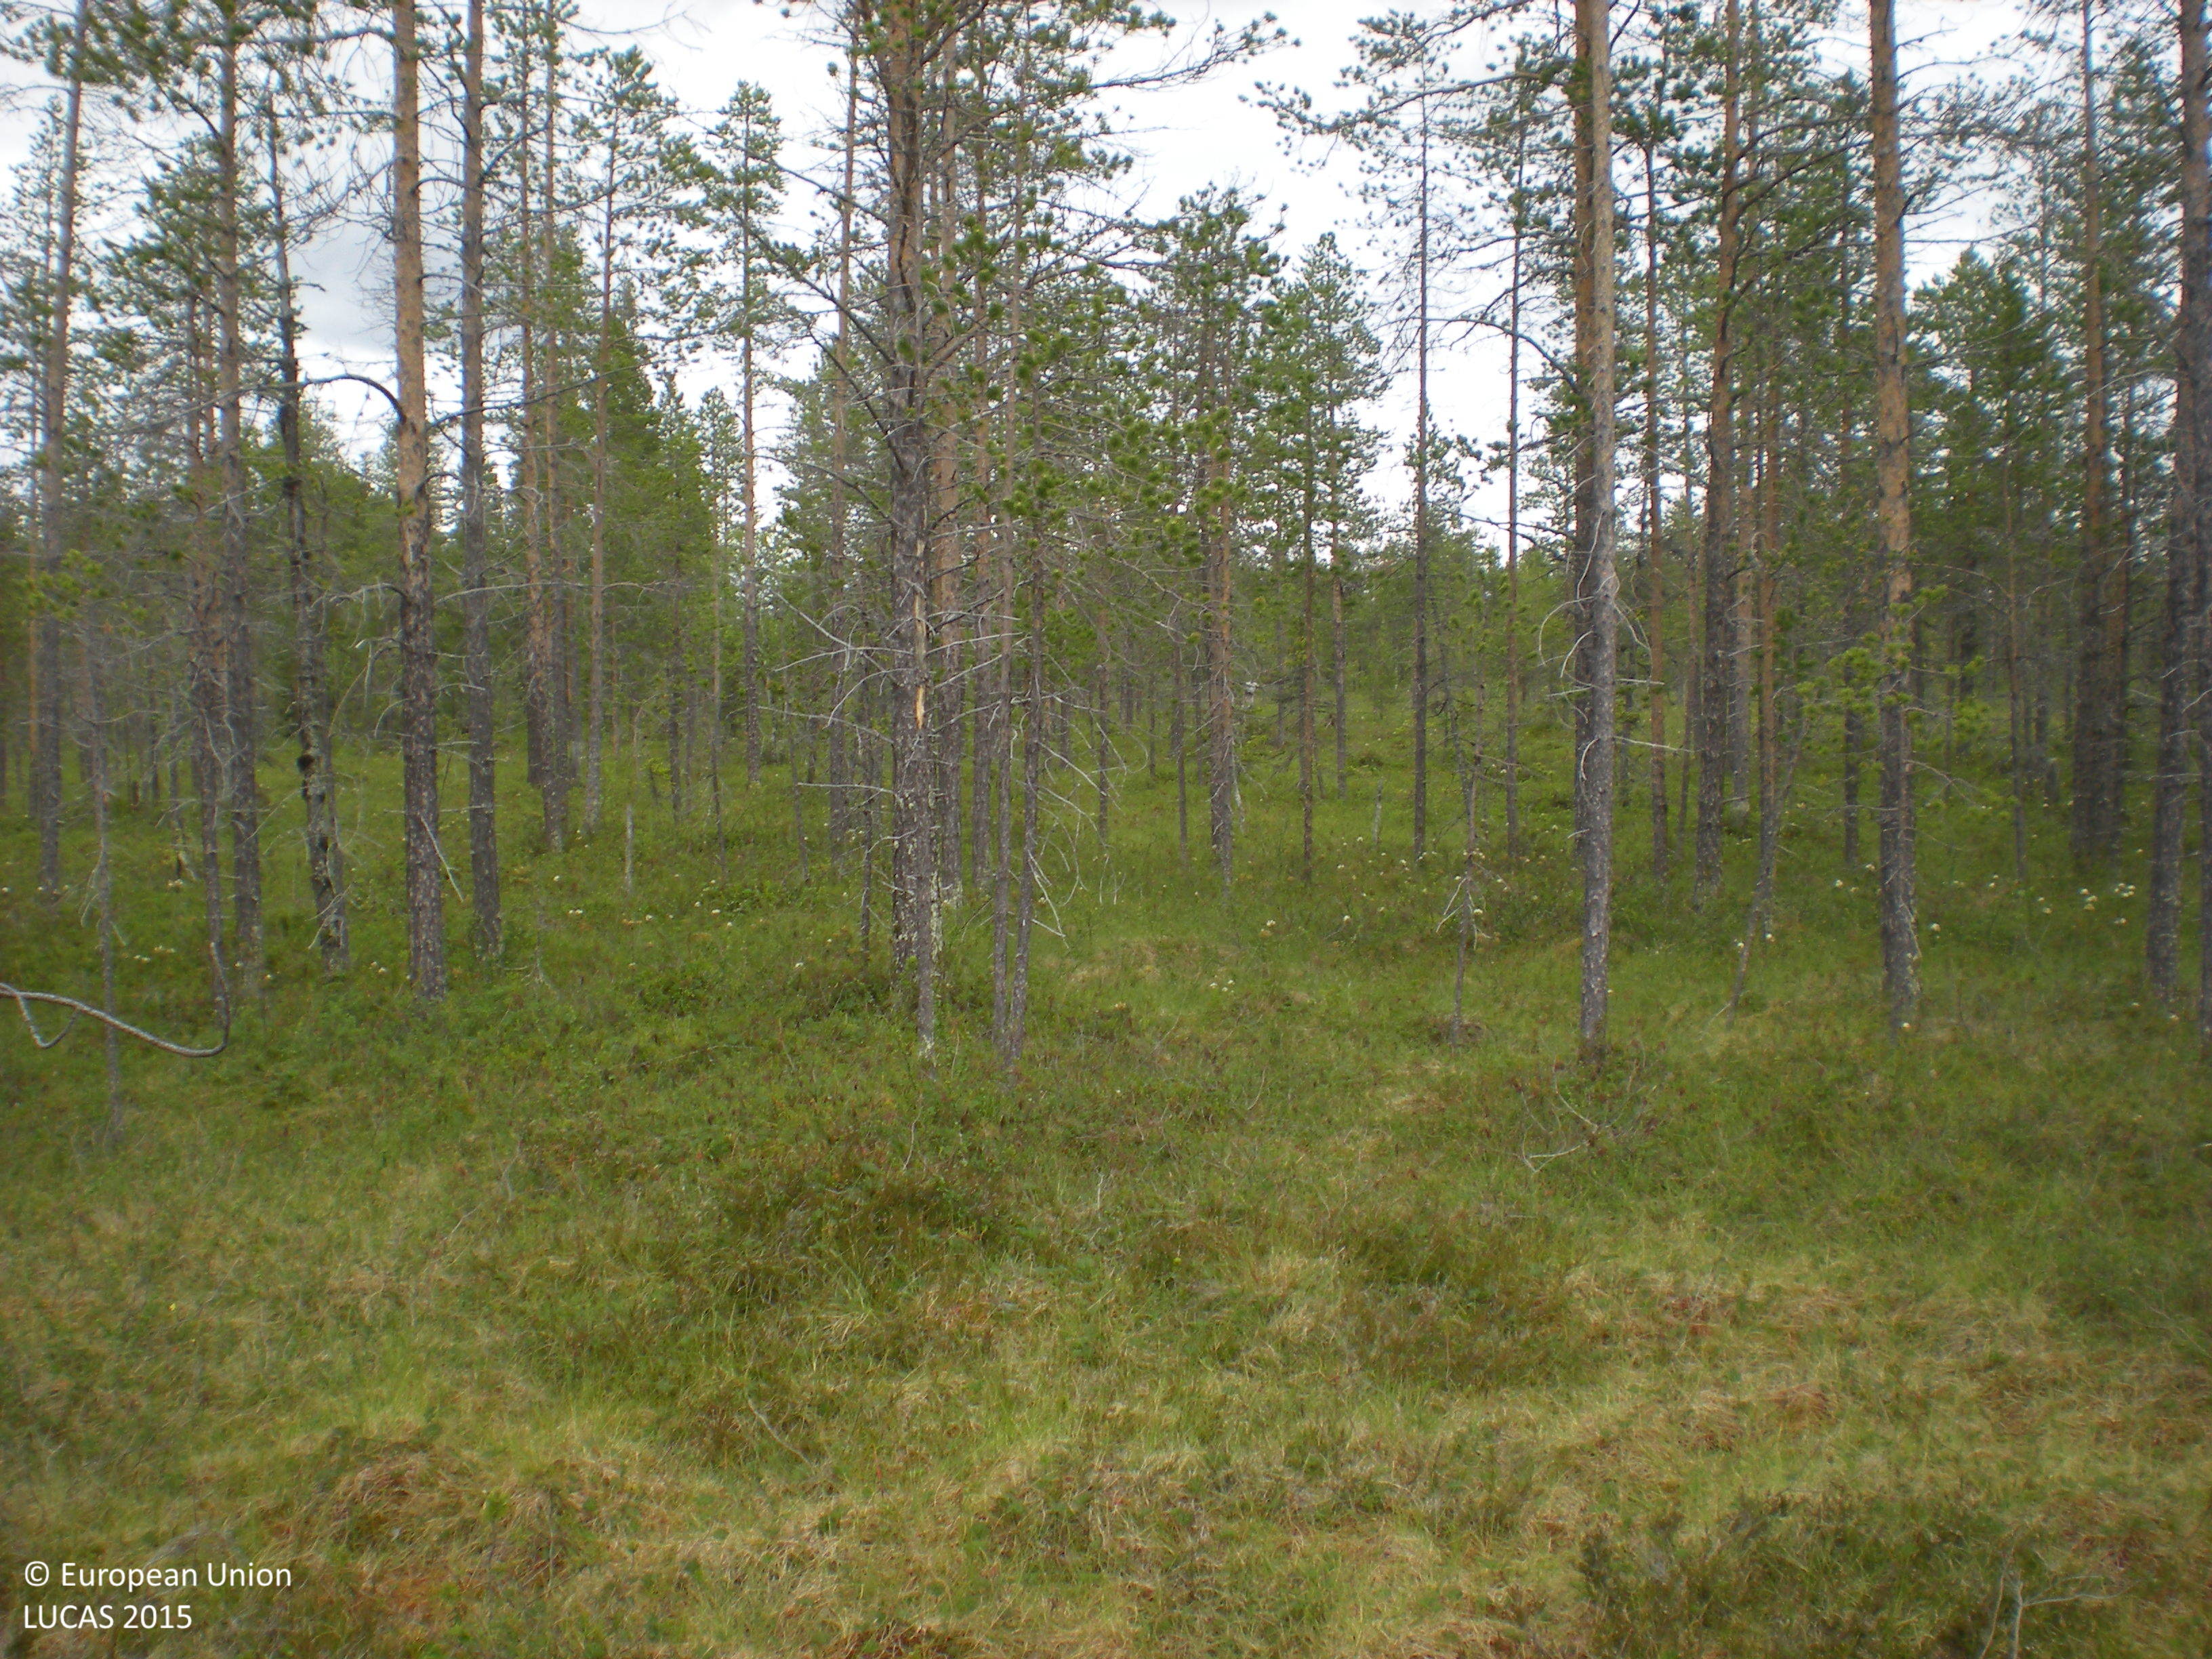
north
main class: Woodland
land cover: Pine dominated coniferous woodland
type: mire and swamp forests
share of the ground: 10 - 25 %
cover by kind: herbaceous plants 55 %, coniferous forest trees 20 %, shrubs 15 %, lichens and mosses 10 %
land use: Semi-natural and natural areas not in use
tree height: < 5 m
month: July
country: SE
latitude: 65.6429
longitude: 18.1508
